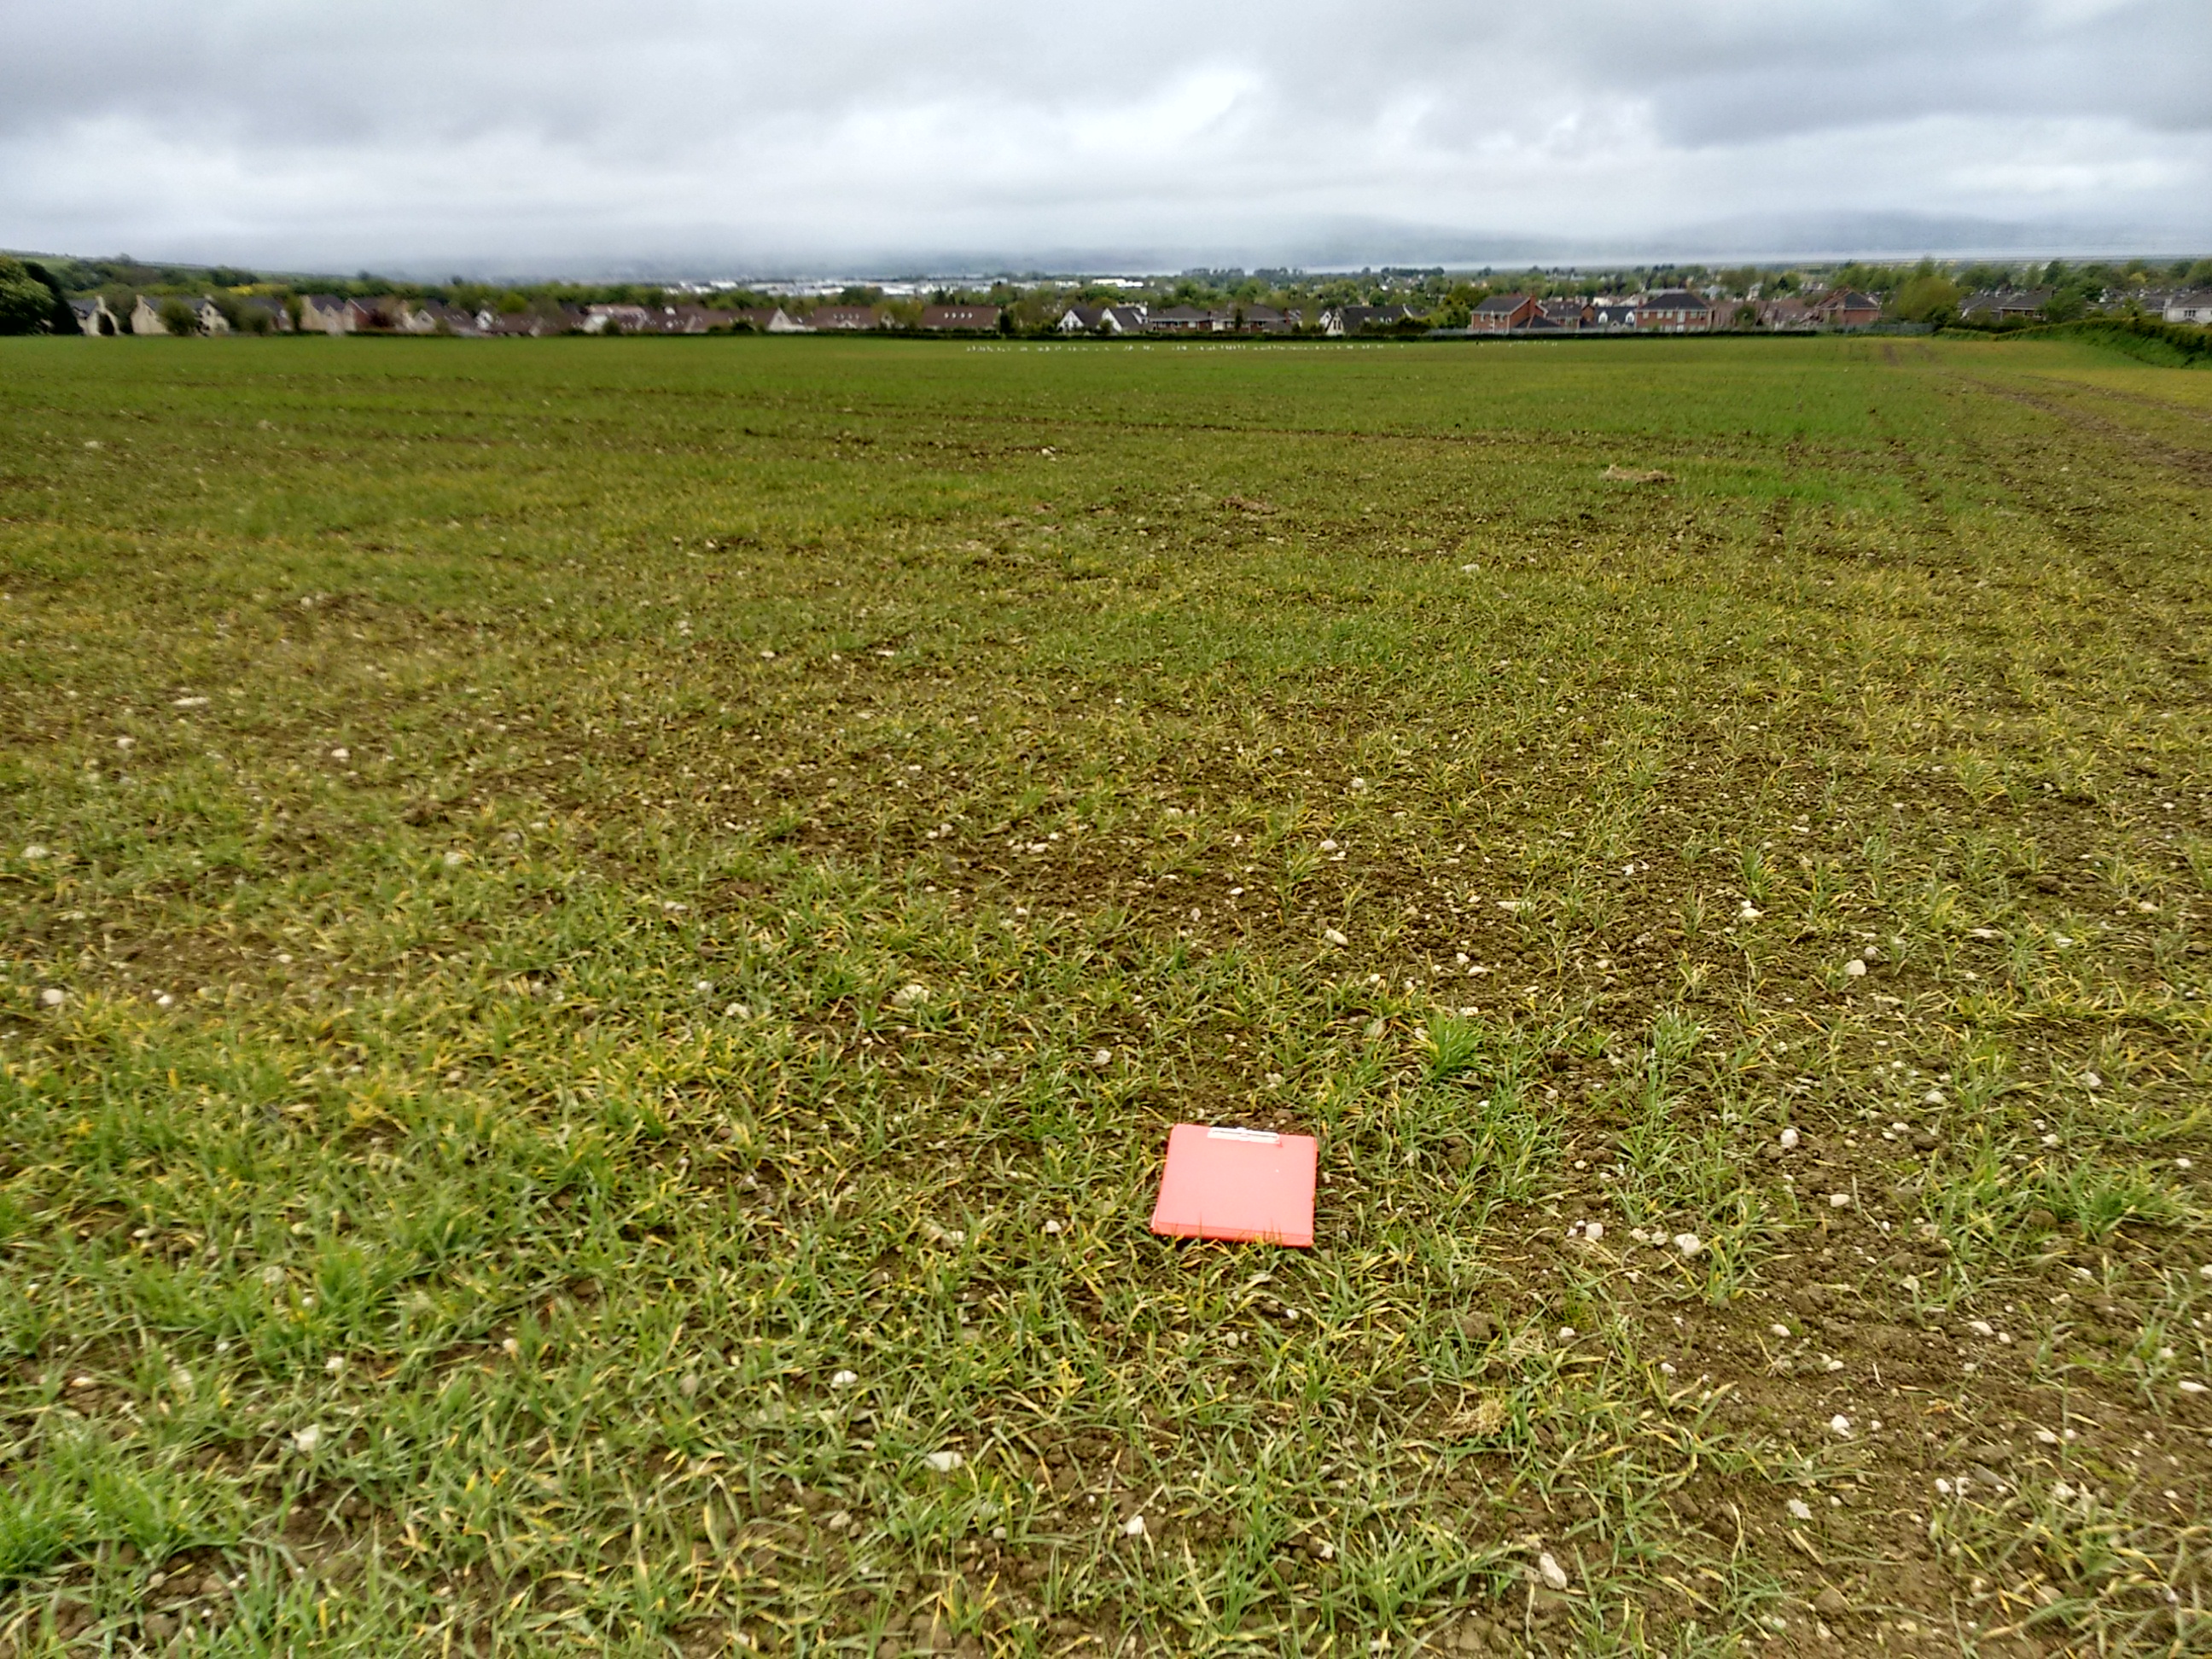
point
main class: Cropland
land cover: Barley
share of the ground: > 75 %
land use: Agriculture (excluding fallow land and kitchen gardens)
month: May
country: GB
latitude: 55.0162
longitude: -7.1746
